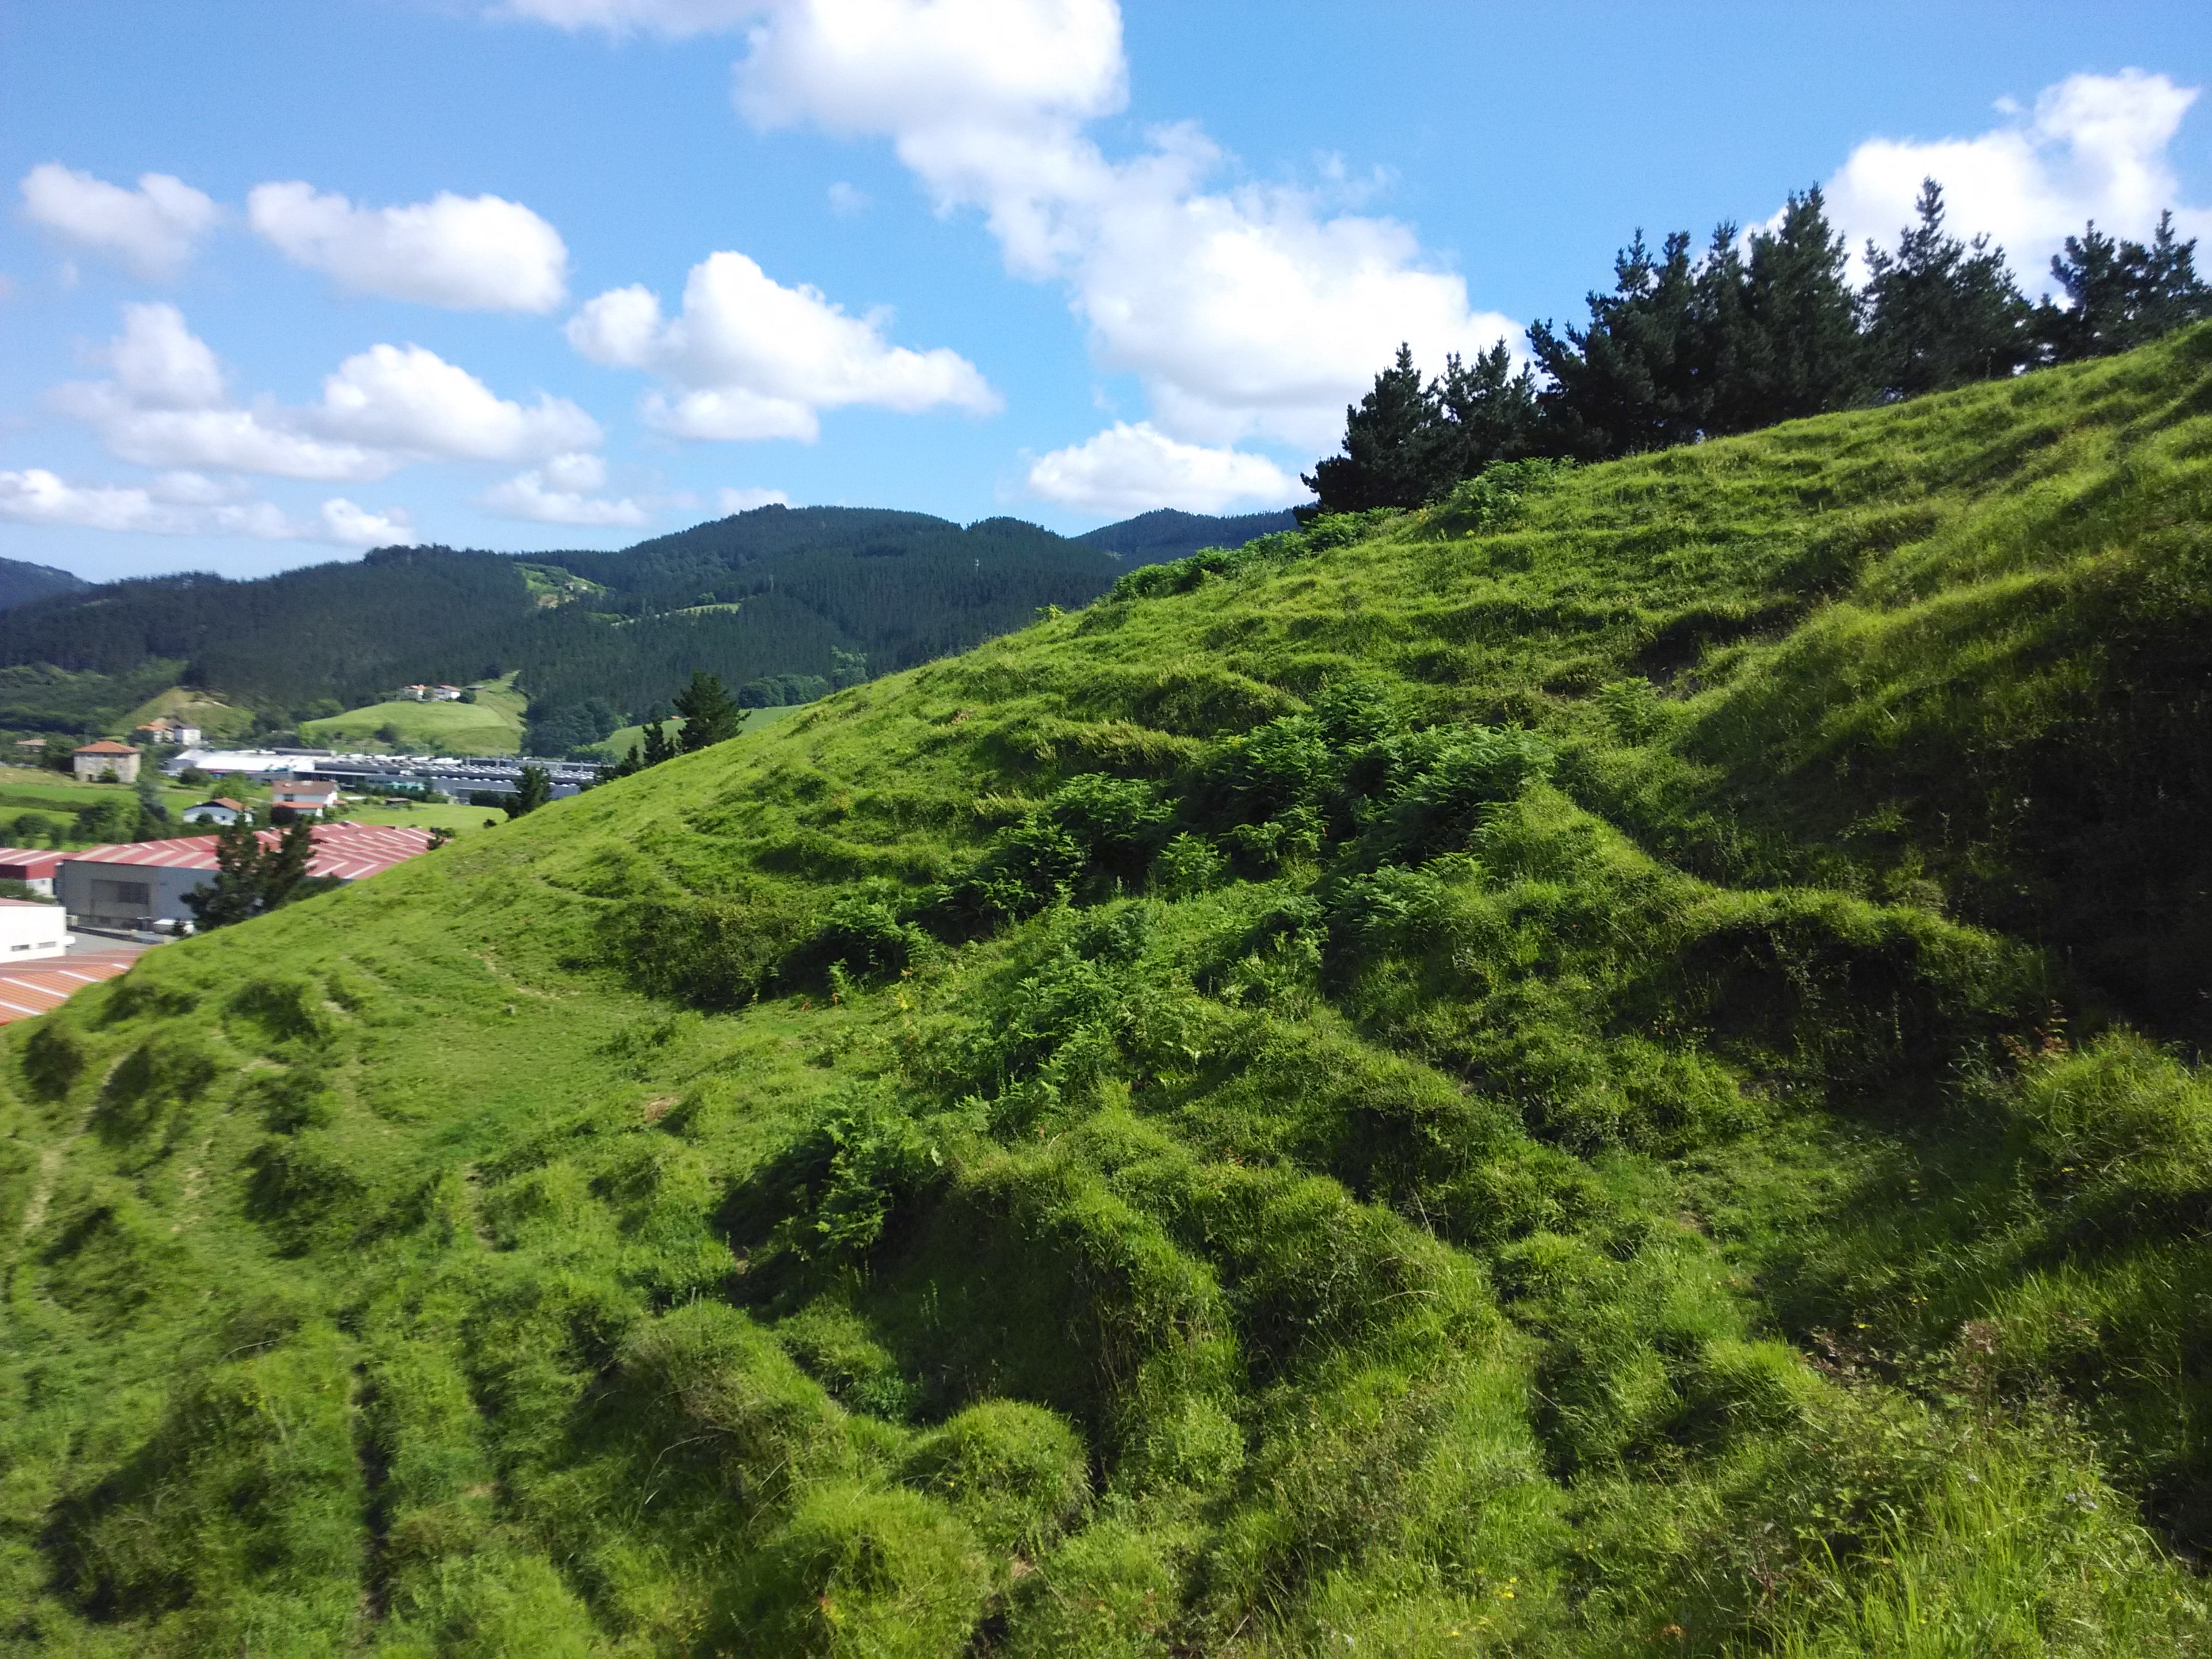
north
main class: Grassland
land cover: Grassland without tree/shrub cover
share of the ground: > 75 %
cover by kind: herbaceous plants 100 %
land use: Agriculture (excluding fallow land and kitchen gardens)
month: June
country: ES
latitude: 43.2474
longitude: -2.4797
